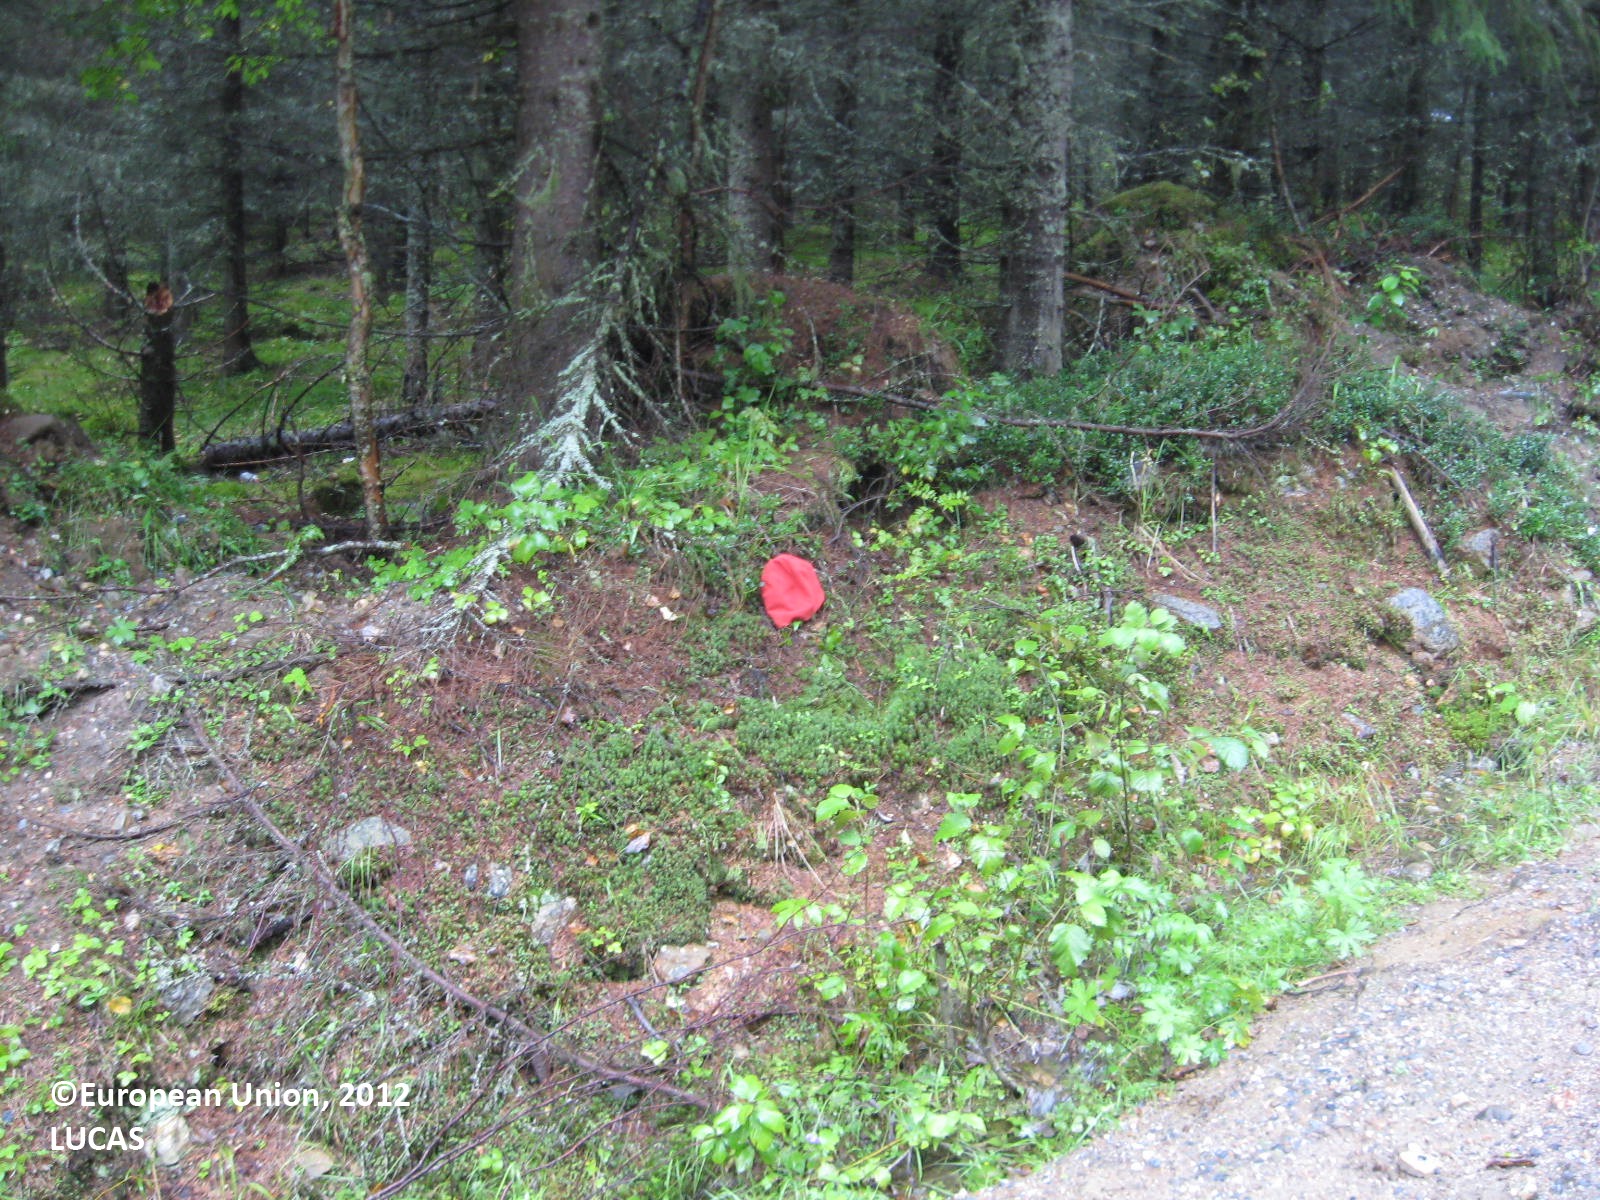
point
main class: Woodland
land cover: Spruce dominated coniferous woodland
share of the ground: > 75 %
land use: Forestry
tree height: > 5 m
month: August
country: FI
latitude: 63.5694
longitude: 29.5809
